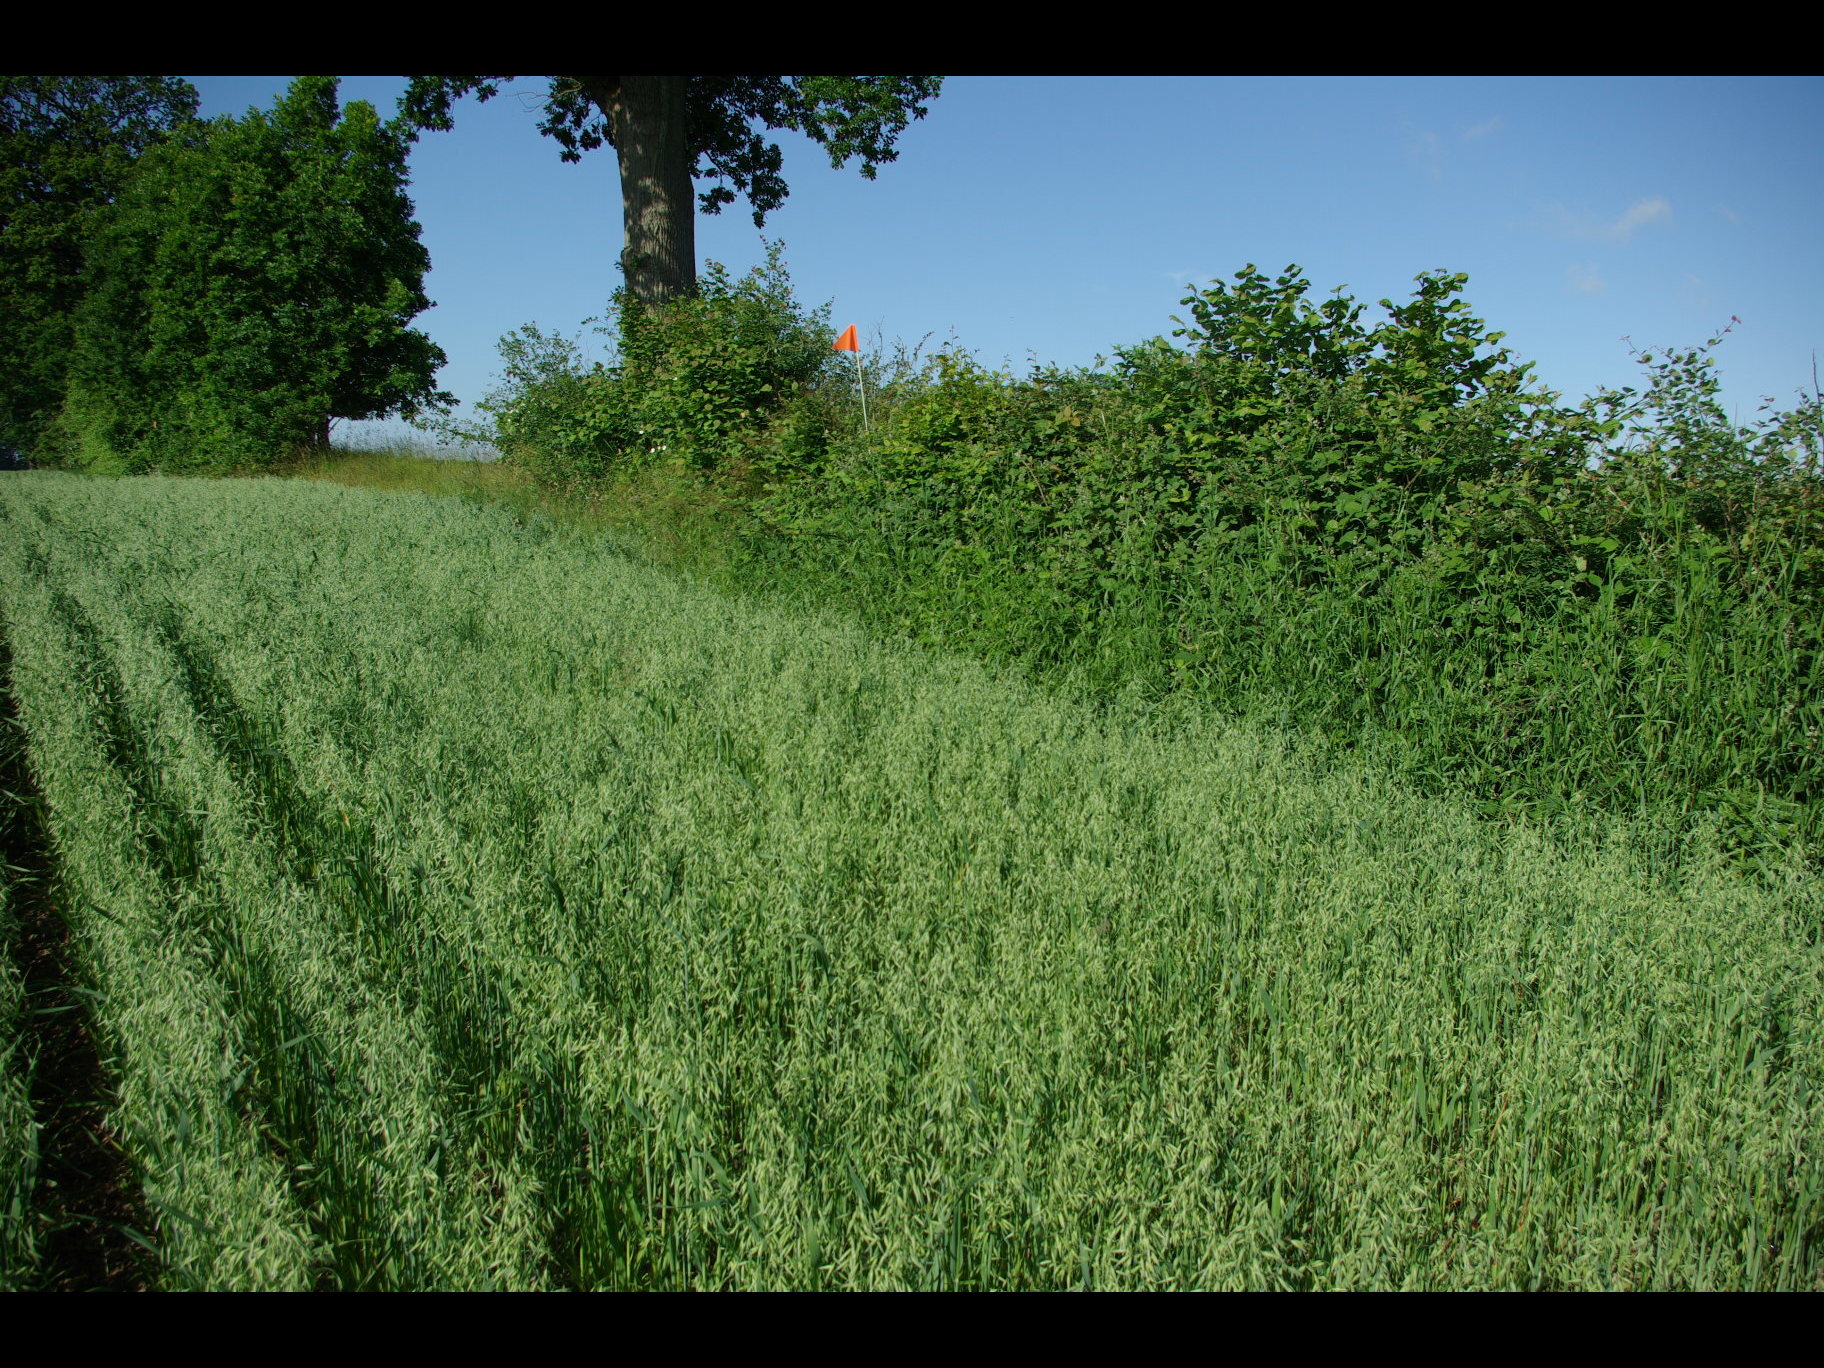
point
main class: Woodland
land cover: Broadleaved woodland
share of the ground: > 75 %
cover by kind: broadleaved forest trees 40 %, shrubs 40 %, herbaceous plants 20 %
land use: Agriculture (excluding fallow land and kitchen gardens)
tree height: > 5 m
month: June
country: DE
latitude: 54.3724
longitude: 9.9538
